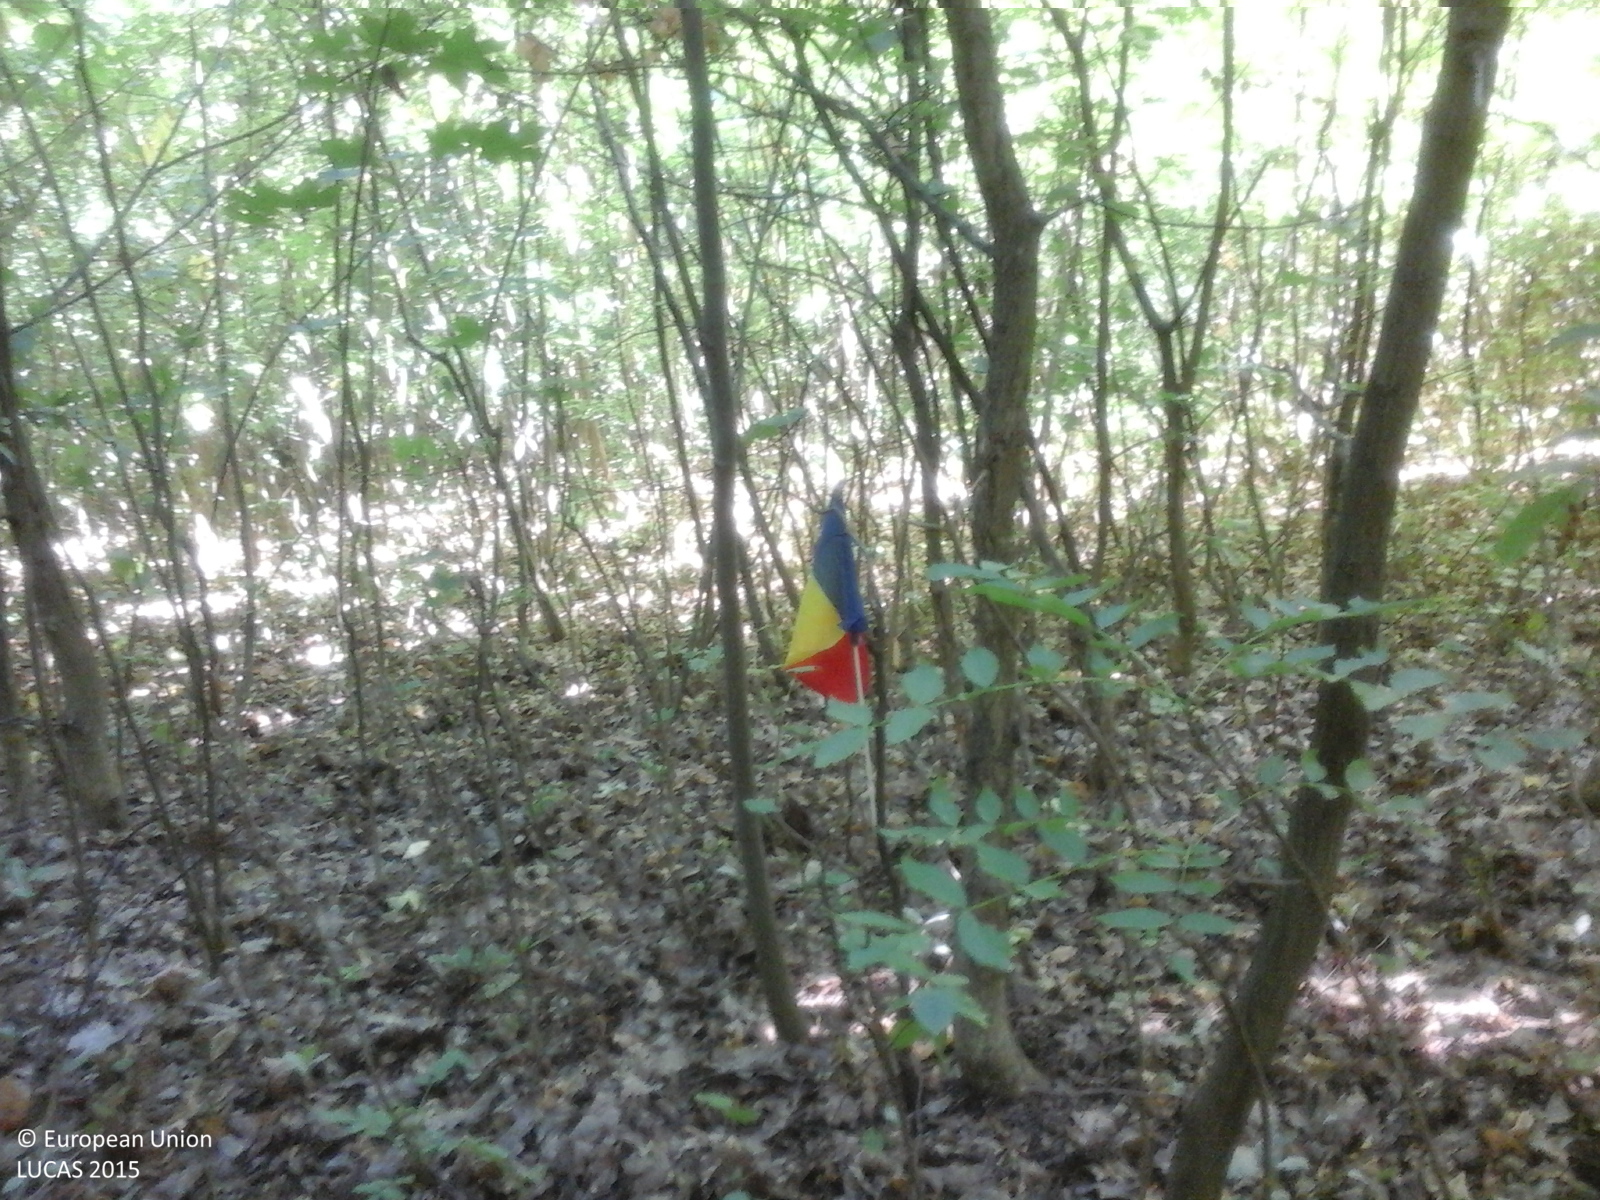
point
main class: Woodland
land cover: Broadleaved woodland
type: thermophilous deciduous forest
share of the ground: > 75 %
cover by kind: broadleaved forest trees 100 %
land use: Forestry
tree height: > 5 m
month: June
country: RO
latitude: 47.0862
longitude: 27.3805
